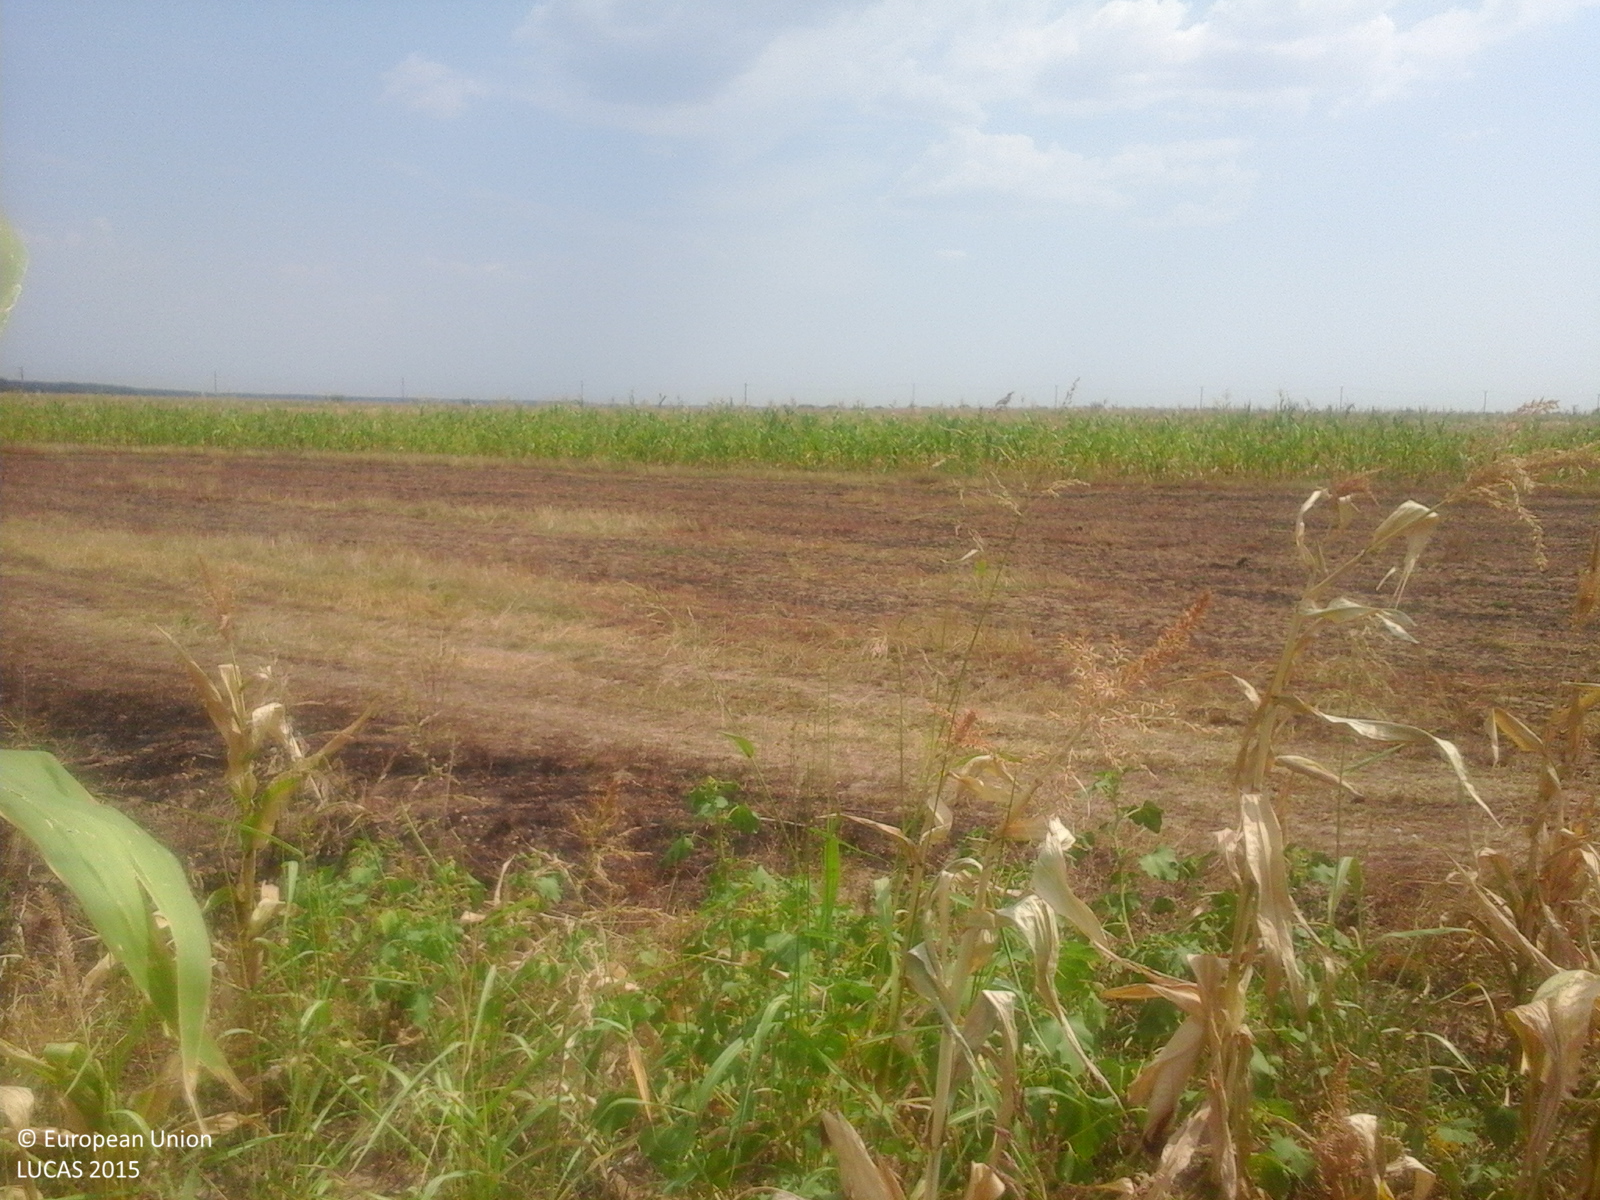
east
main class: Cropland
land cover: Maize
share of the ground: > 75 %
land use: Agriculture (excluding fallow land and kitchen gardens)
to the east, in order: Maize; Spontaneously vegetated surfaces; Common wheat; Spontaneously vegetated surfaces; Maize; Spontaneously vegetated surfaces; Common wheat; Maize; Common wheat
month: August
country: RO
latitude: 44.3212
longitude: 22.7929
